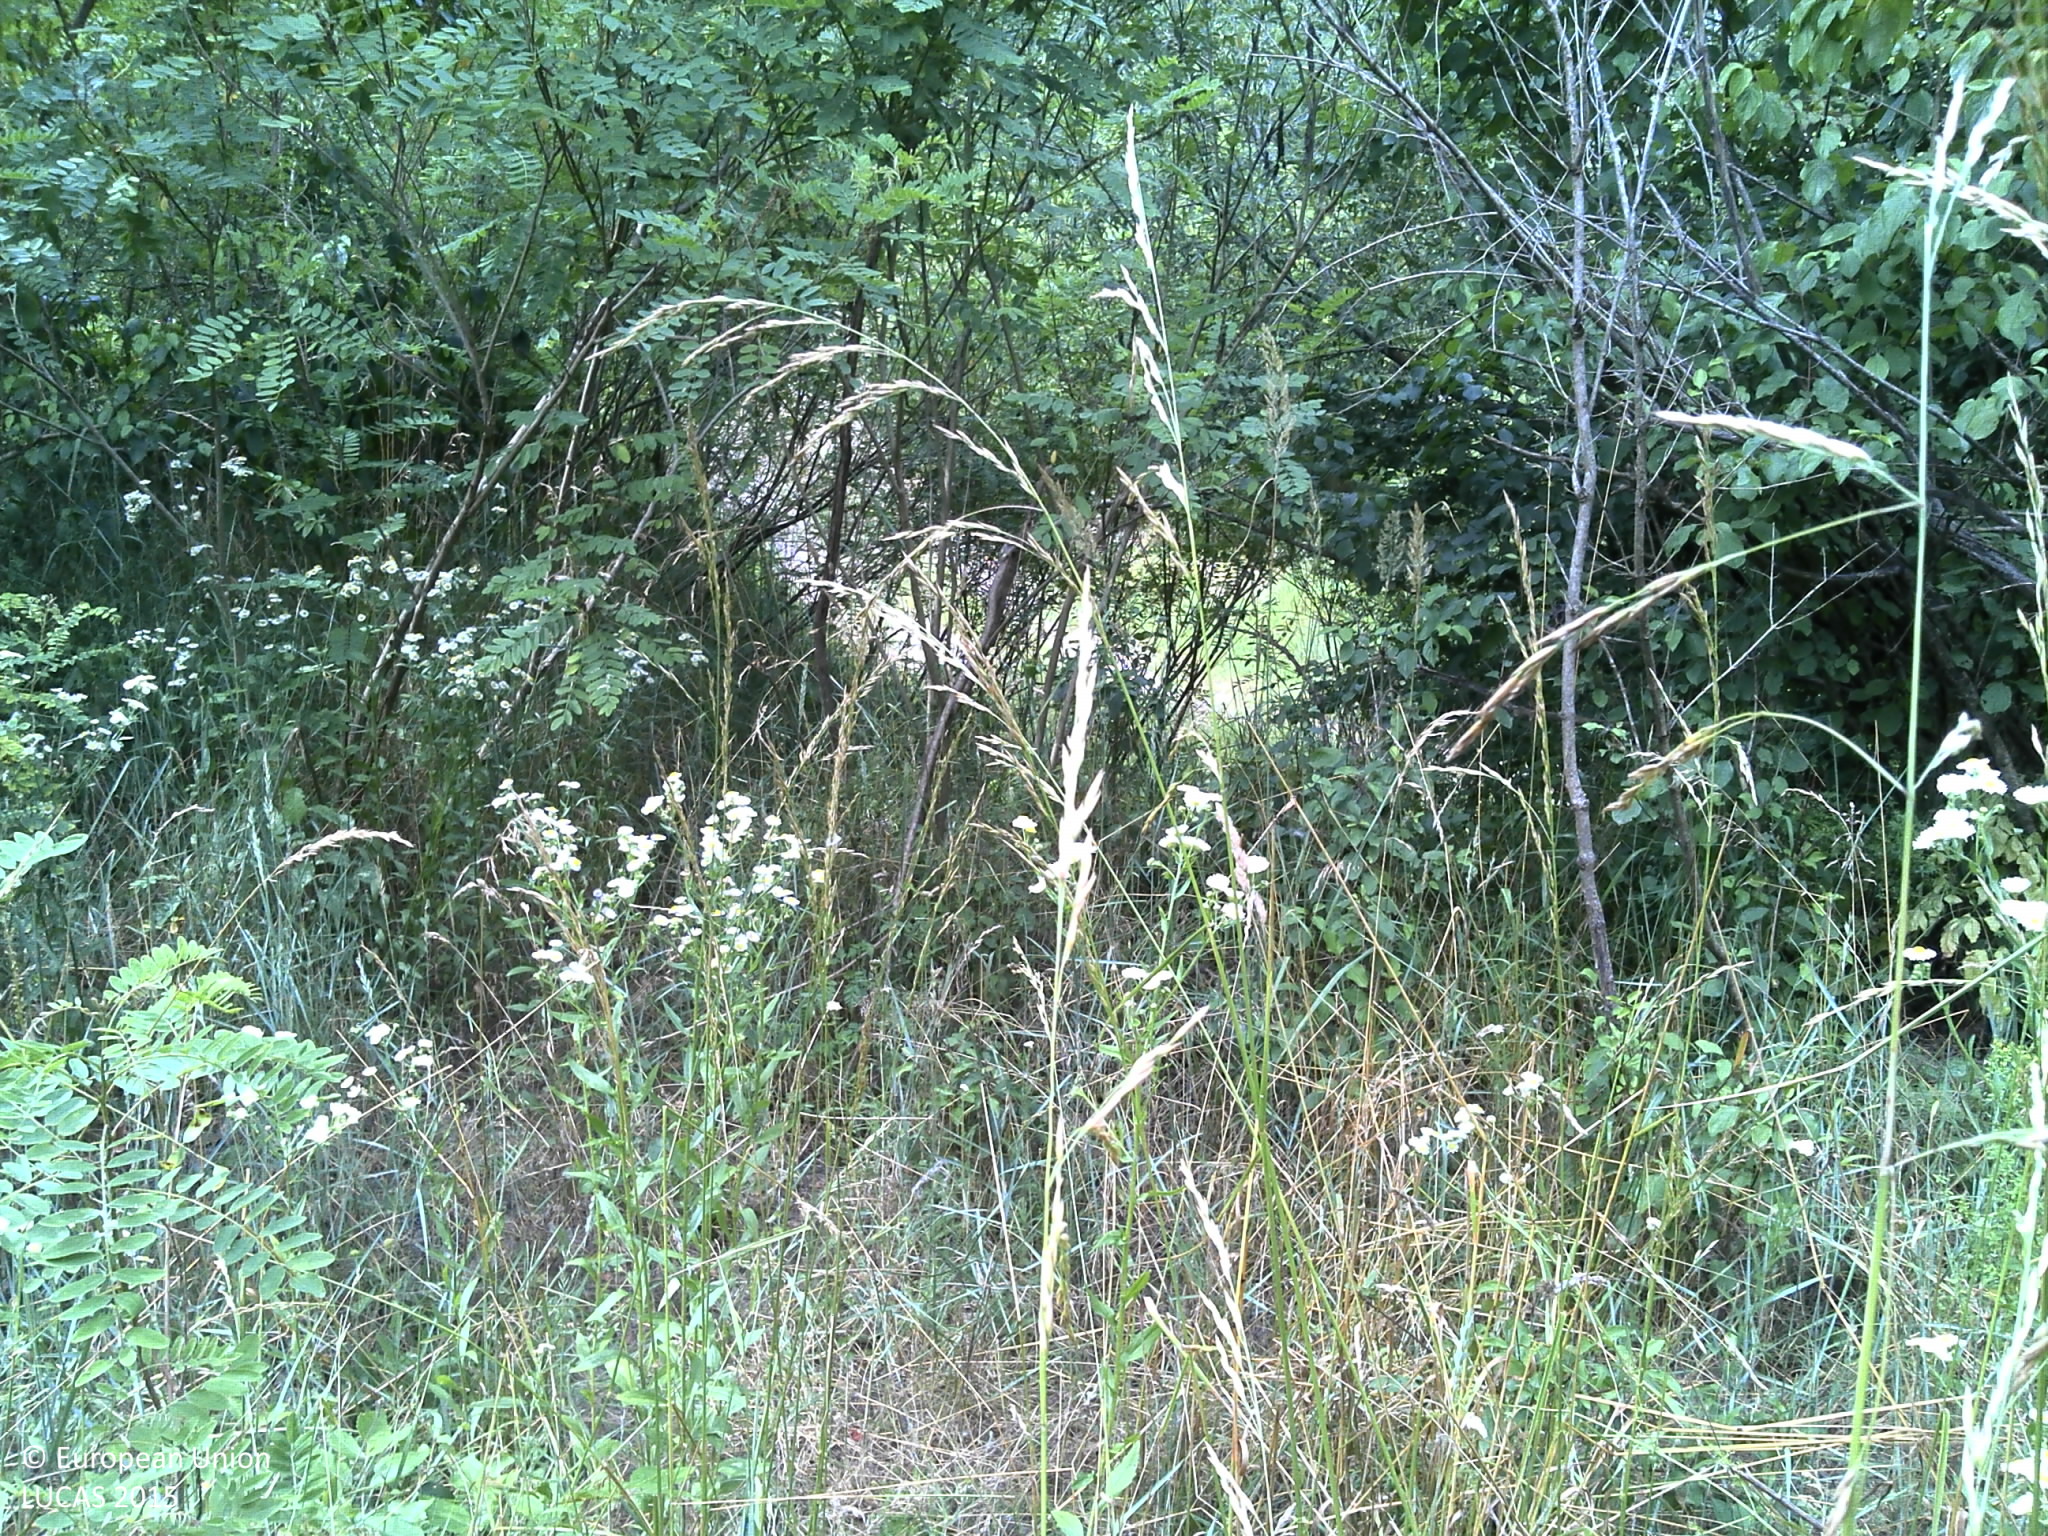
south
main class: Shrubland
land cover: Shrubland with sparse tree cover
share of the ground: > 75 %
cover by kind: shrubs 95 %, broadleaved forest trees 5 %
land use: Forestry
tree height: > 5 m
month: June
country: HR
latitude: 45.9557
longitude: 17.3179
